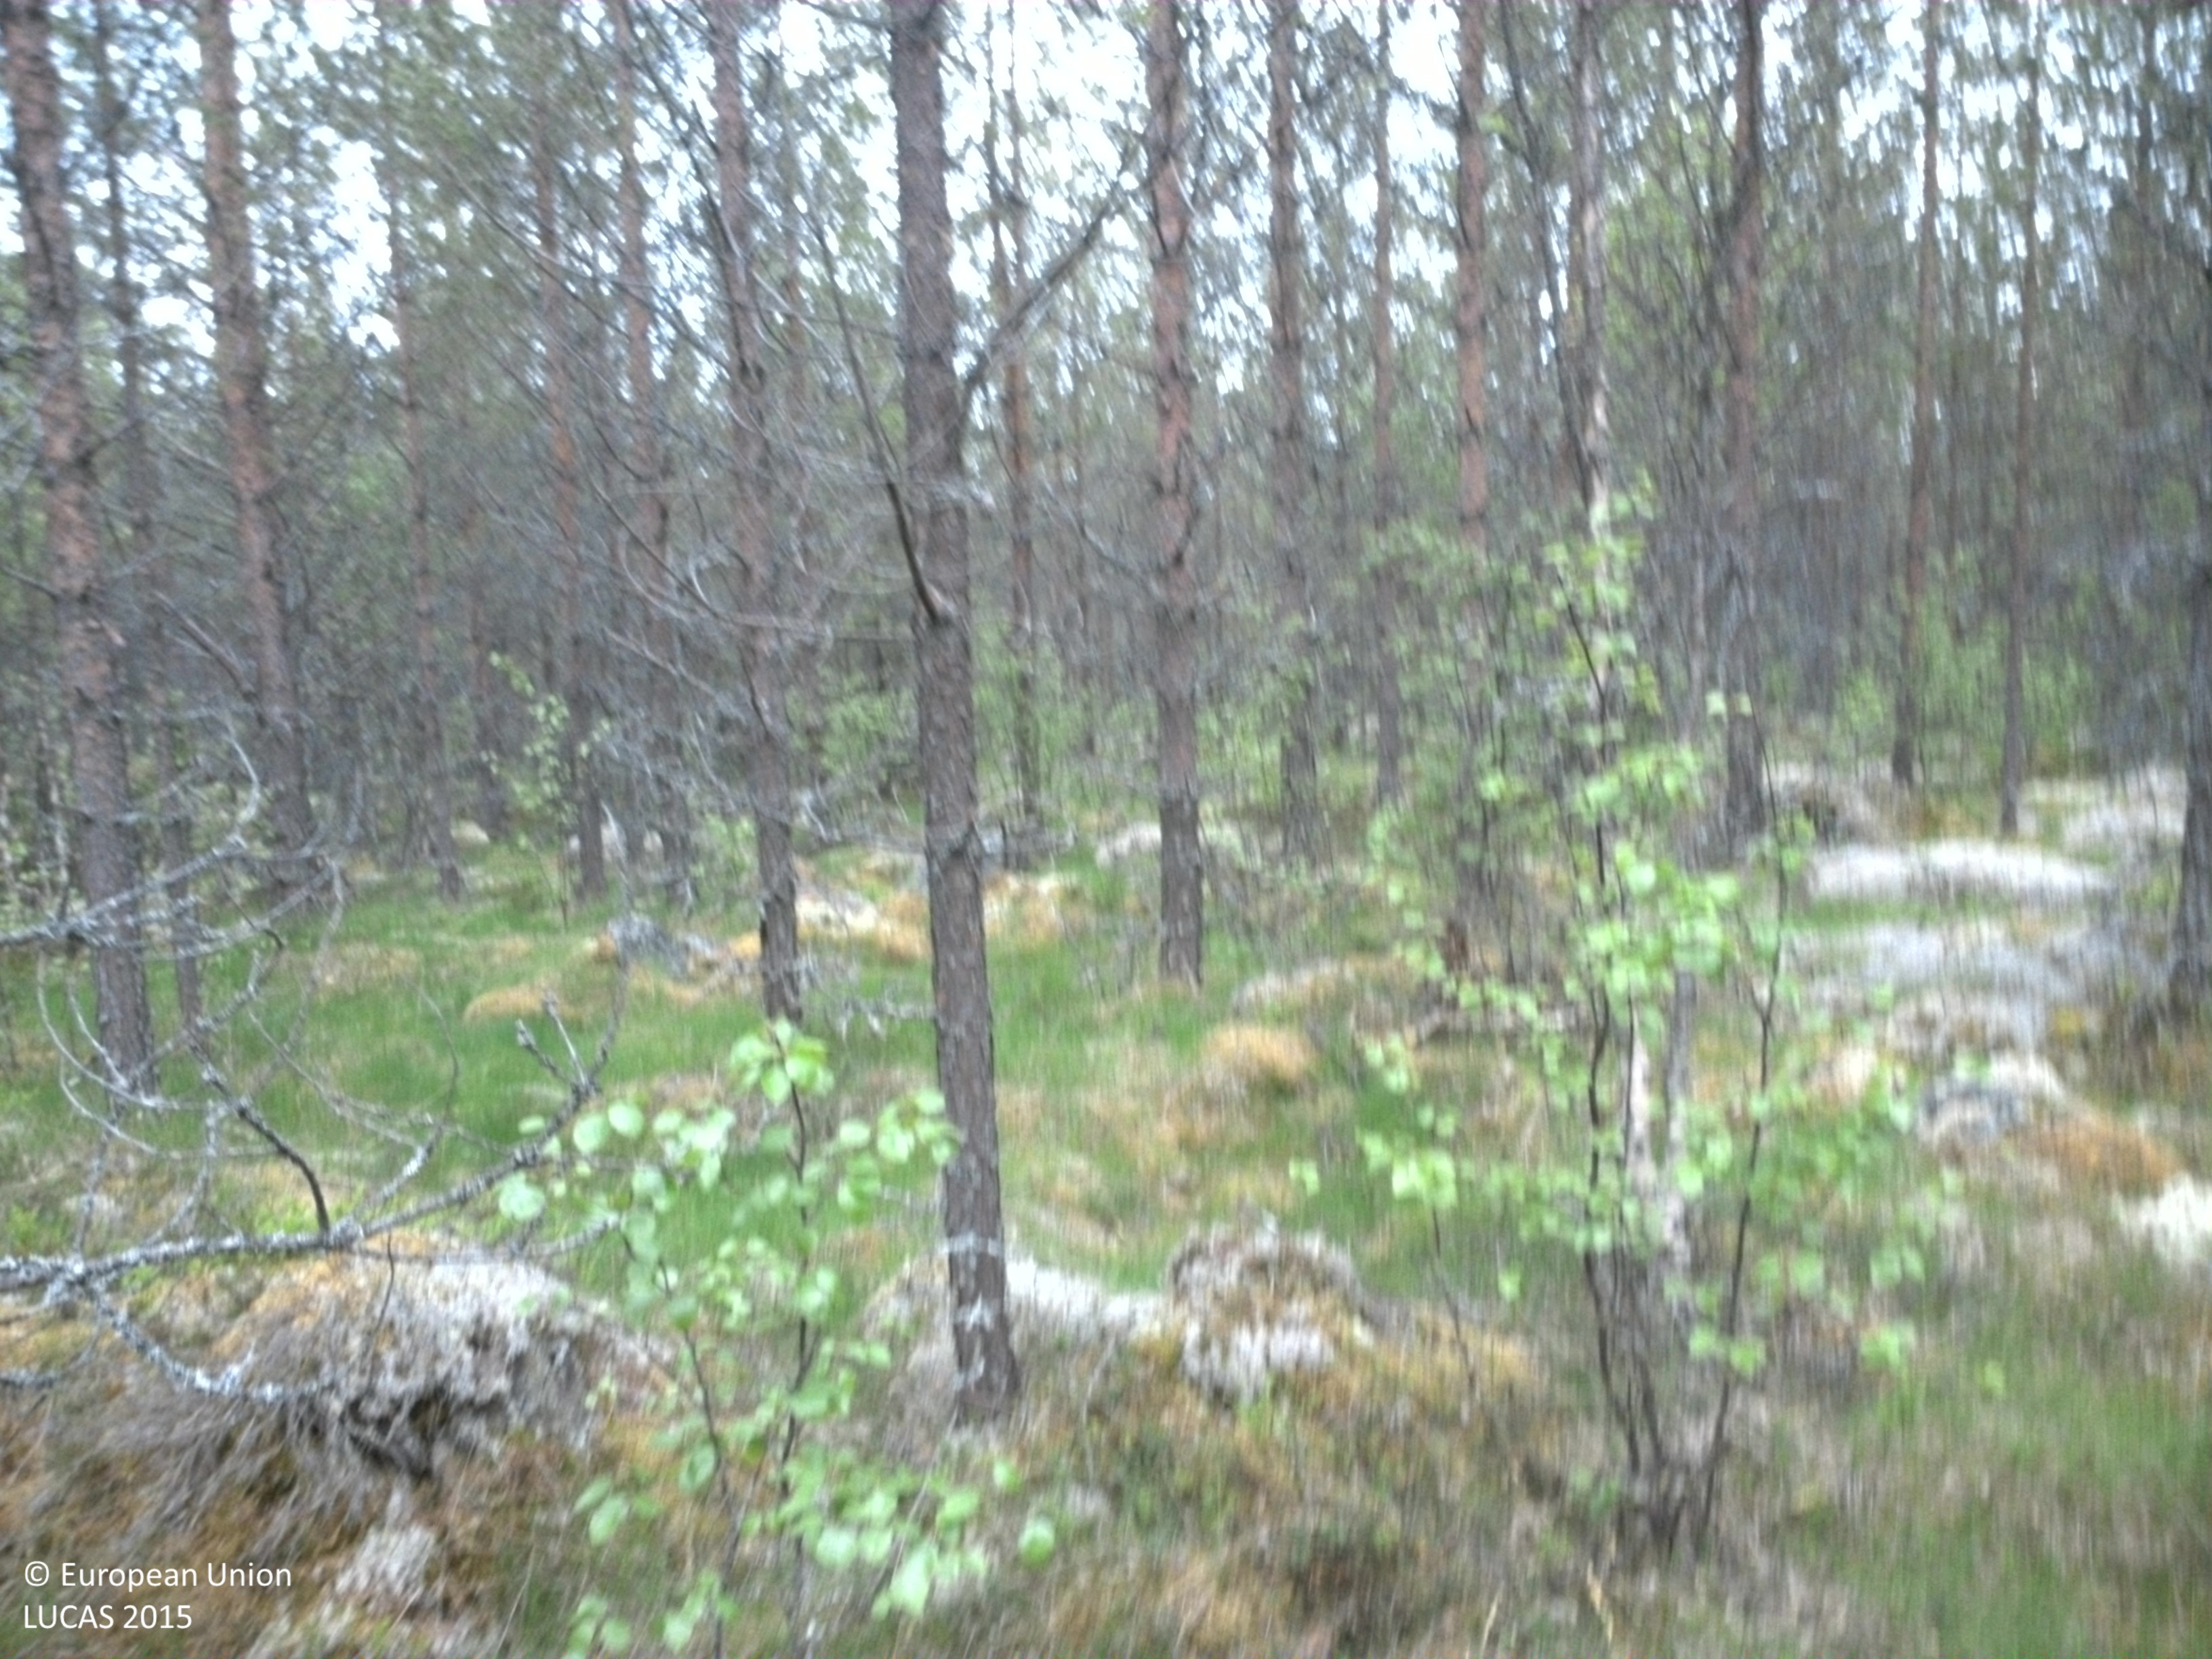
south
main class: Woodland
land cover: Pine dominated coniferous woodland
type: boreal forest
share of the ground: 50 - 75 %
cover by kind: coniferous forest trees 45 %, lichens and mosses 25 %, herbaceous plants 20 %, broadleaved forest trees 5 %, shrubs 5 %
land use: Forestry
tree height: > 5 m
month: June
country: SE
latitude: 61.3660
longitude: 13.3738
